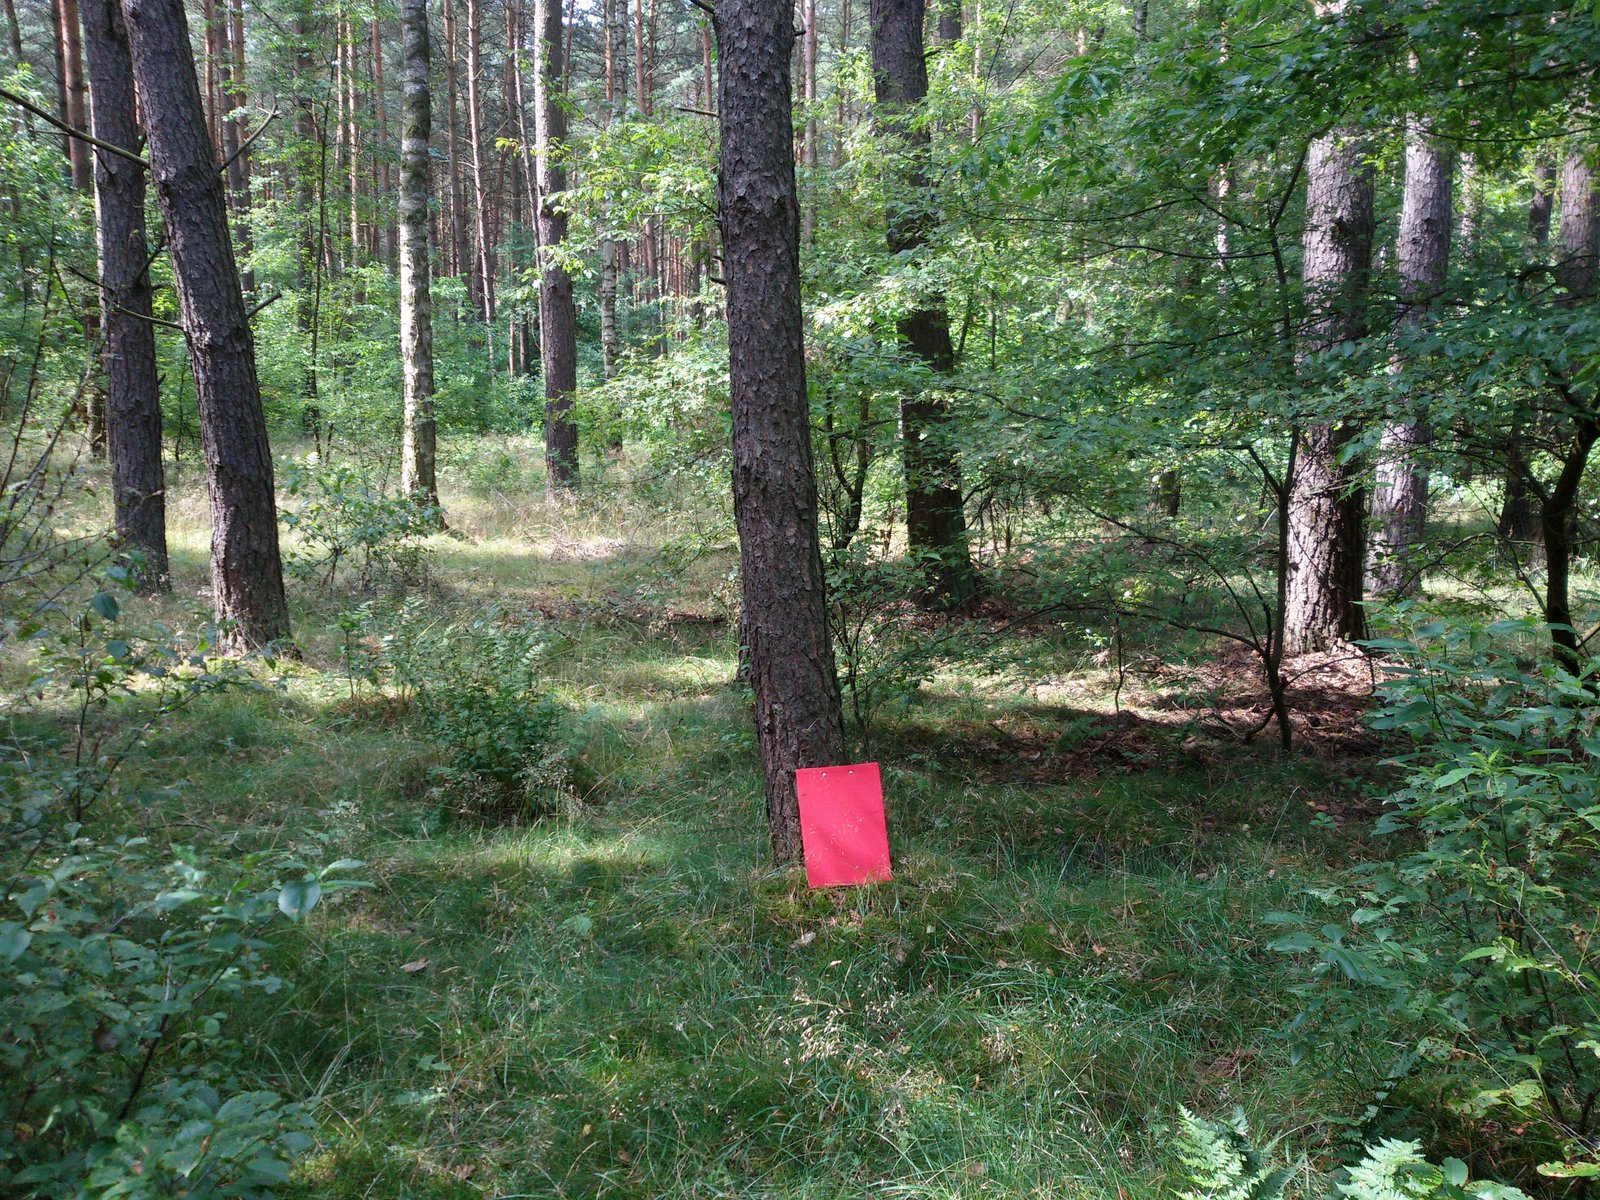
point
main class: Woodland
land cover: Pine dominated mixed woodland
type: hemiboreal forest and nemoral coniferous forest and mixed broadleaved-coniferous forest
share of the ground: > 75 %
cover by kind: coniferous forest trees 60 %, broadleaved forest trees 20 %, shrubs 10 %, herbaceous plants 10 %
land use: Forestry
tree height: > 5 m
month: July
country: PL
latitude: 52.6397
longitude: 17.5939
